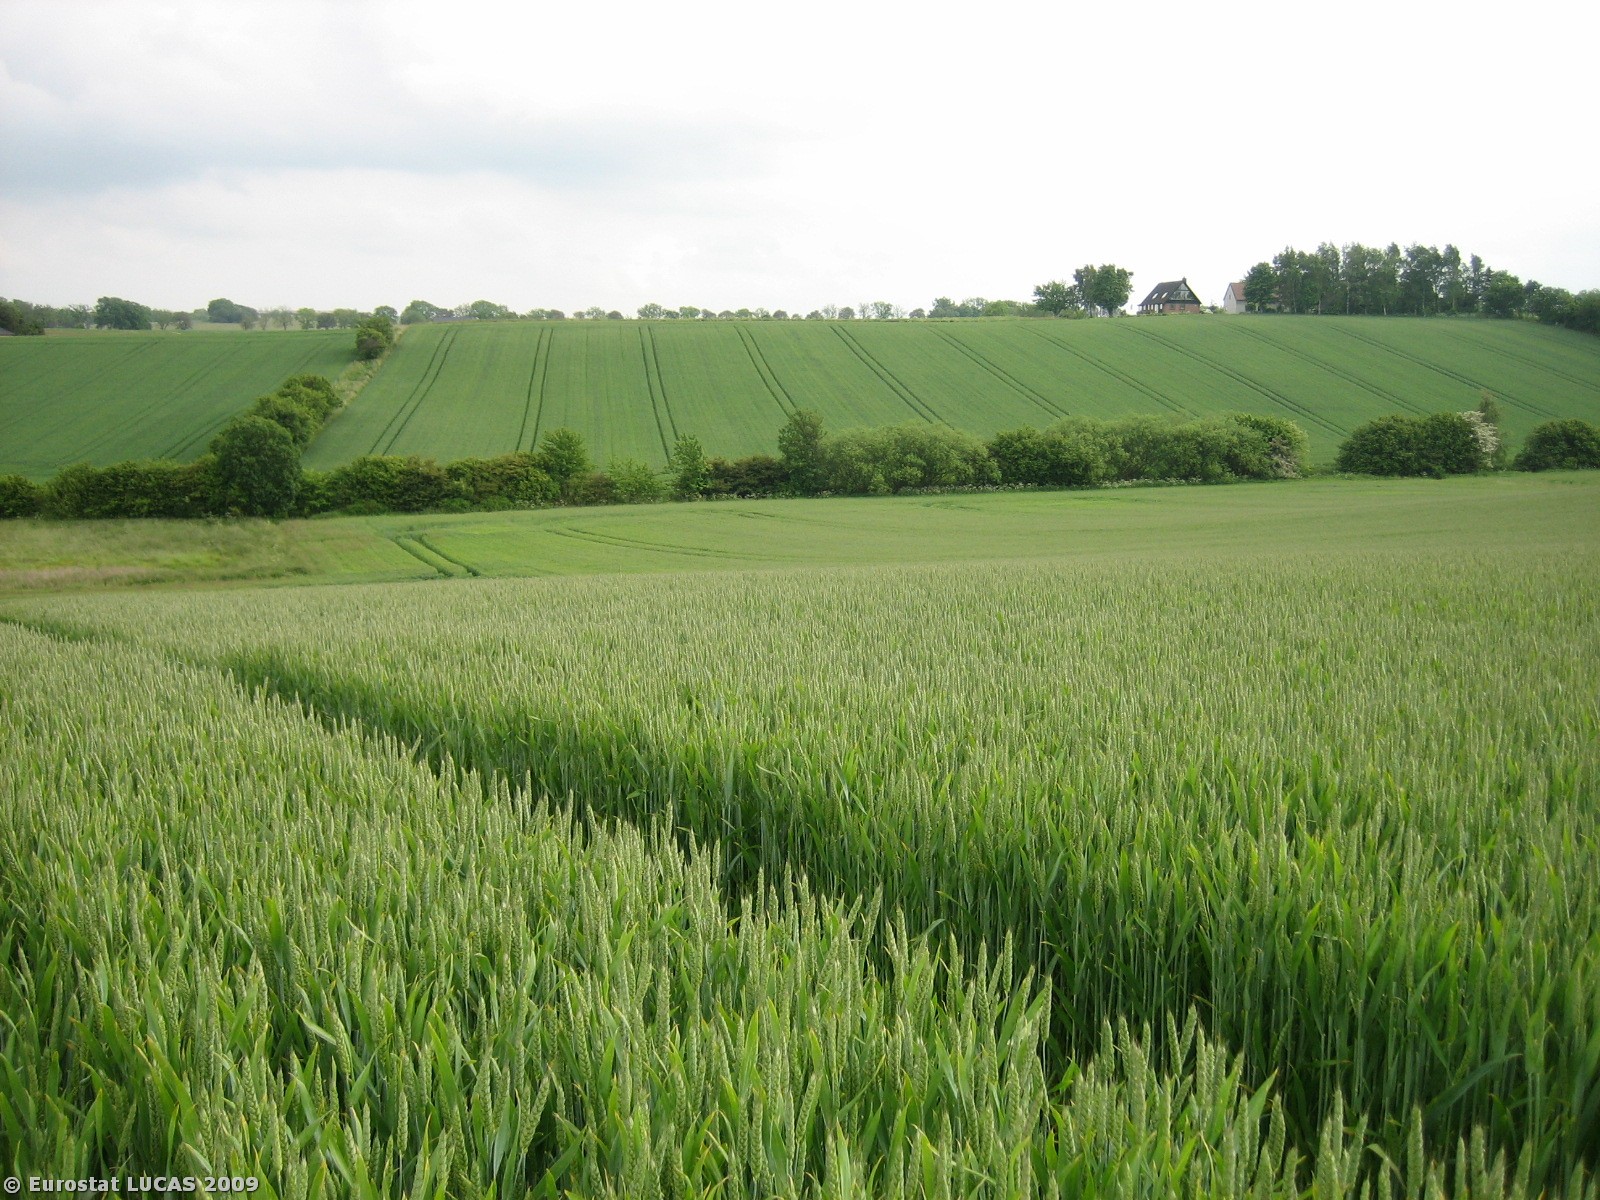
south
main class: Cropland
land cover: Common wheat
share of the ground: > 75 %
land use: Agriculture (excluding fallow land and kitchen gardens)
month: June
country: DK
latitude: 56.0798
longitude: 10.1765
